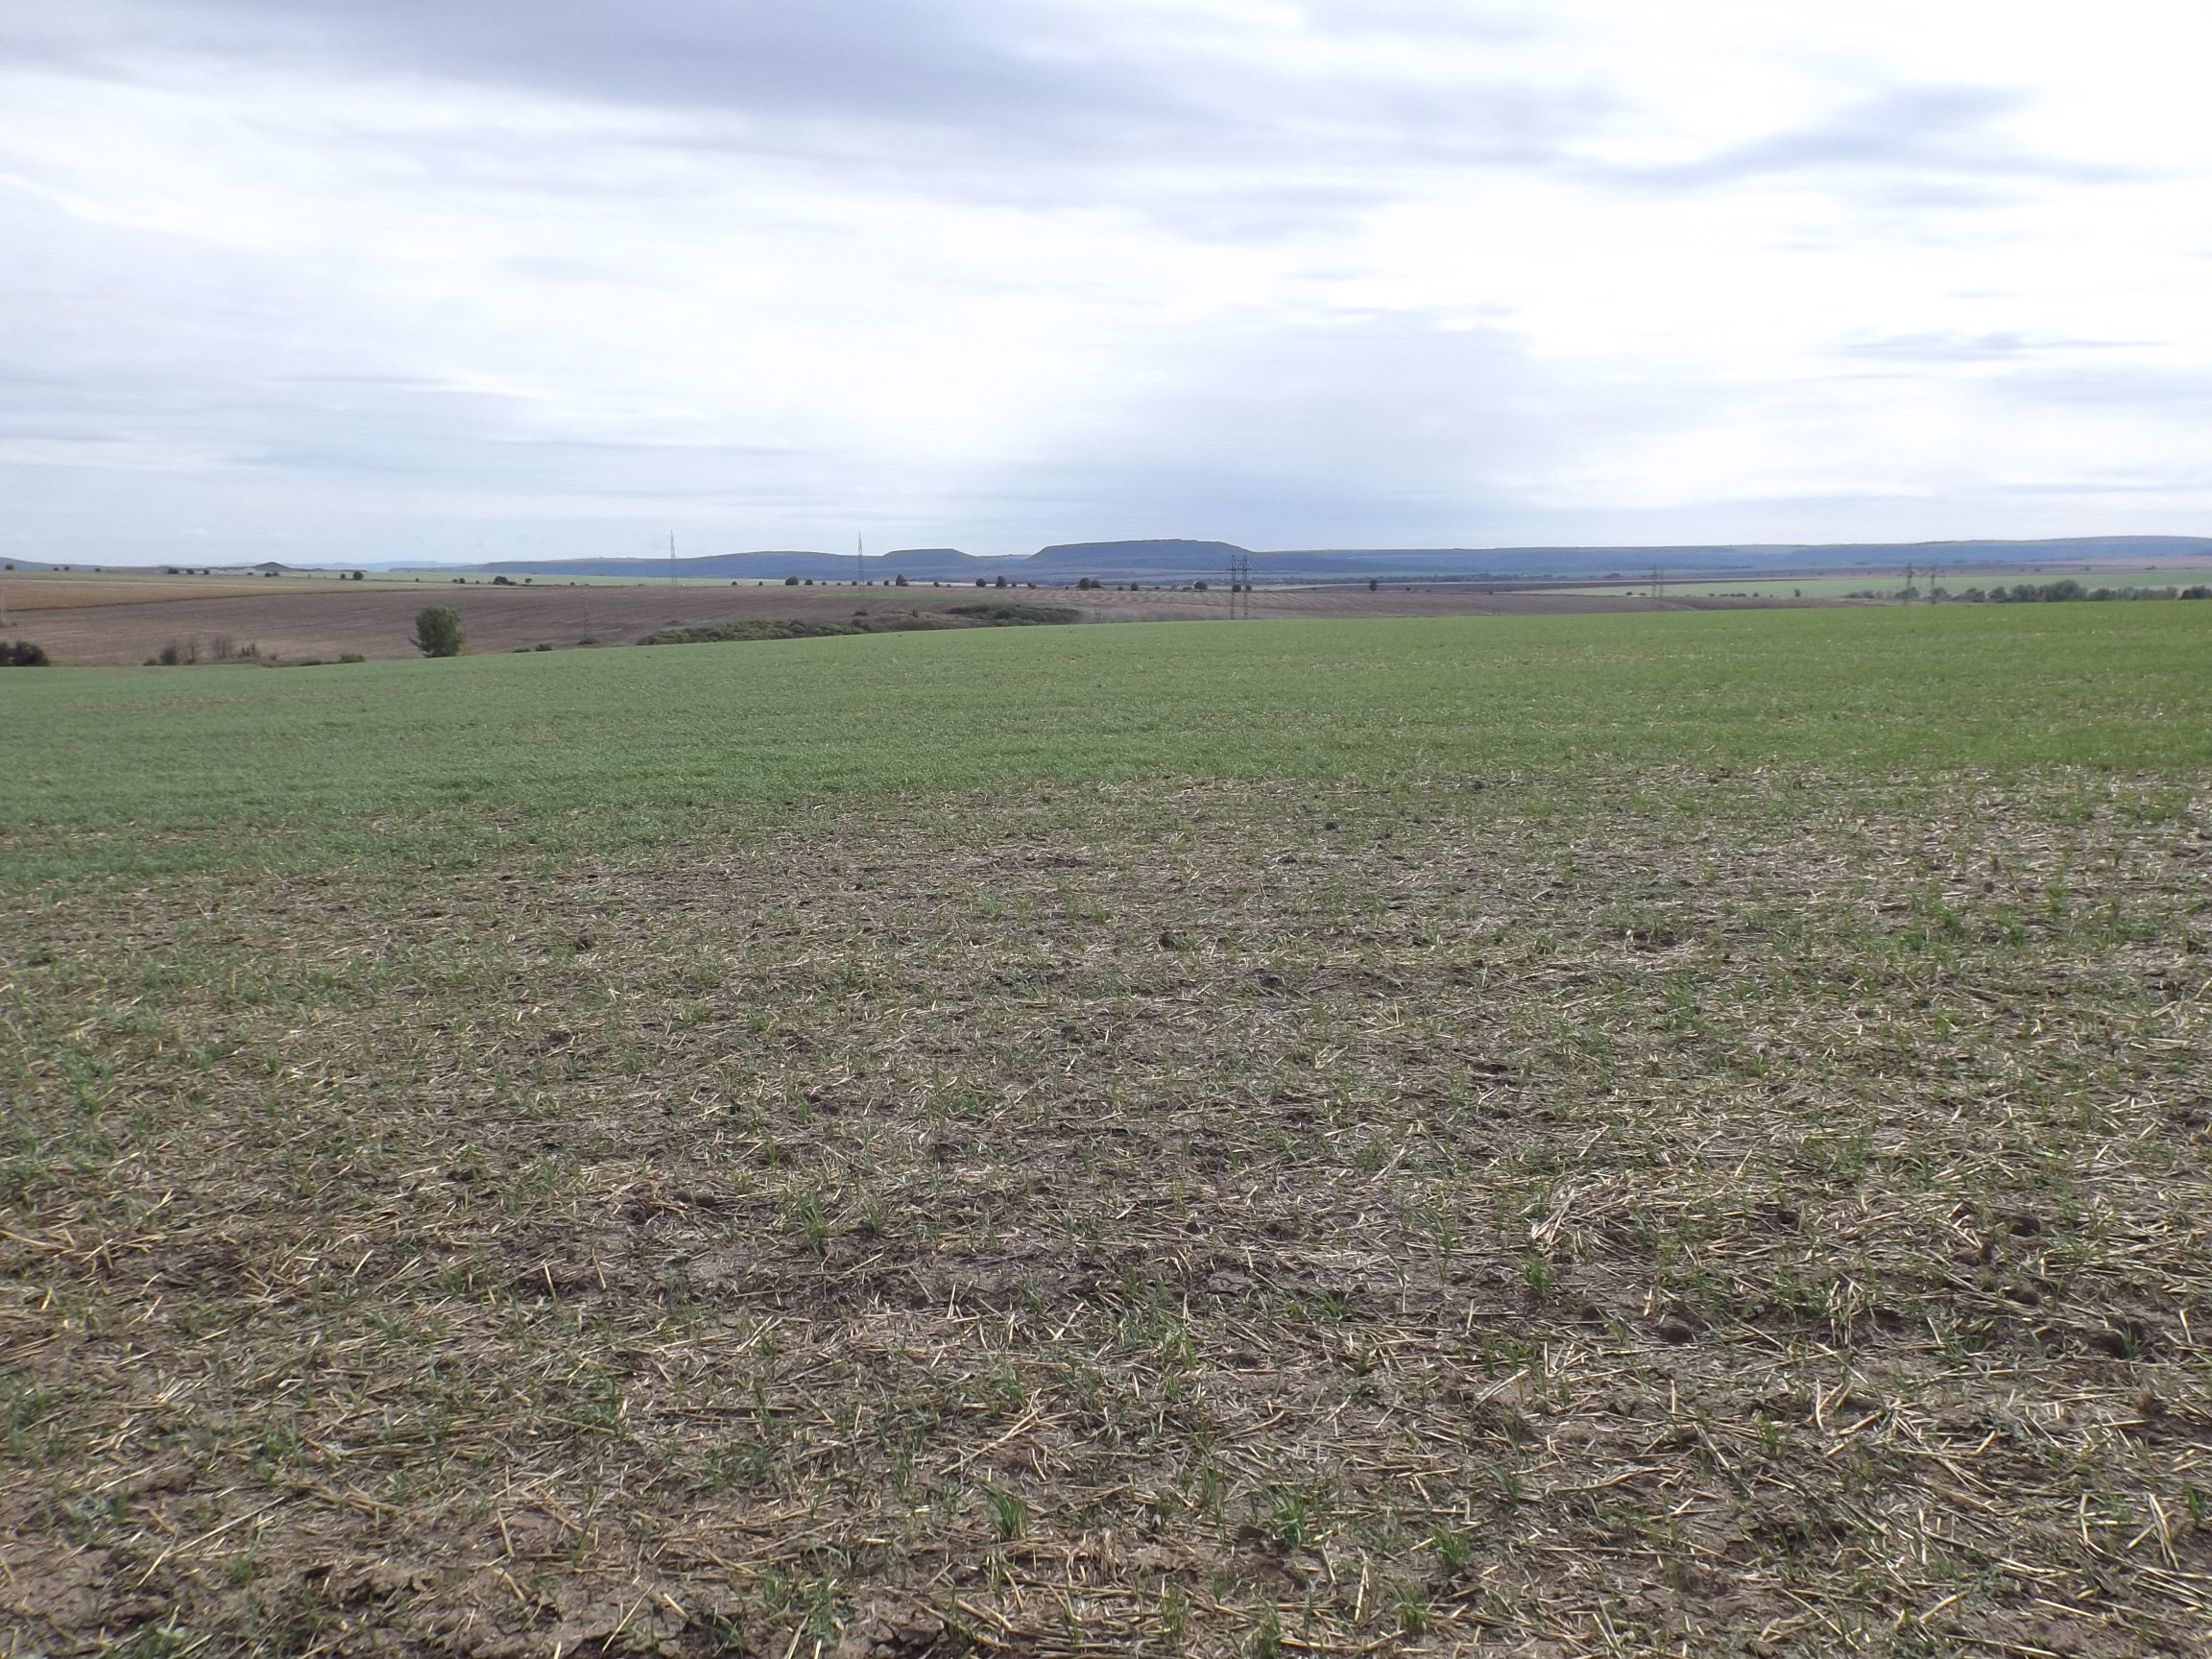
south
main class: Cropland
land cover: Common wheat
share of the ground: < 10 %
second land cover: Spontaneously vegetated surfaces
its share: 10 - 25 %
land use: Agriculture (excluding fallow land and kitchen gardens)
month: September
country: BG
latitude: 43.3306
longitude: 27.3795
